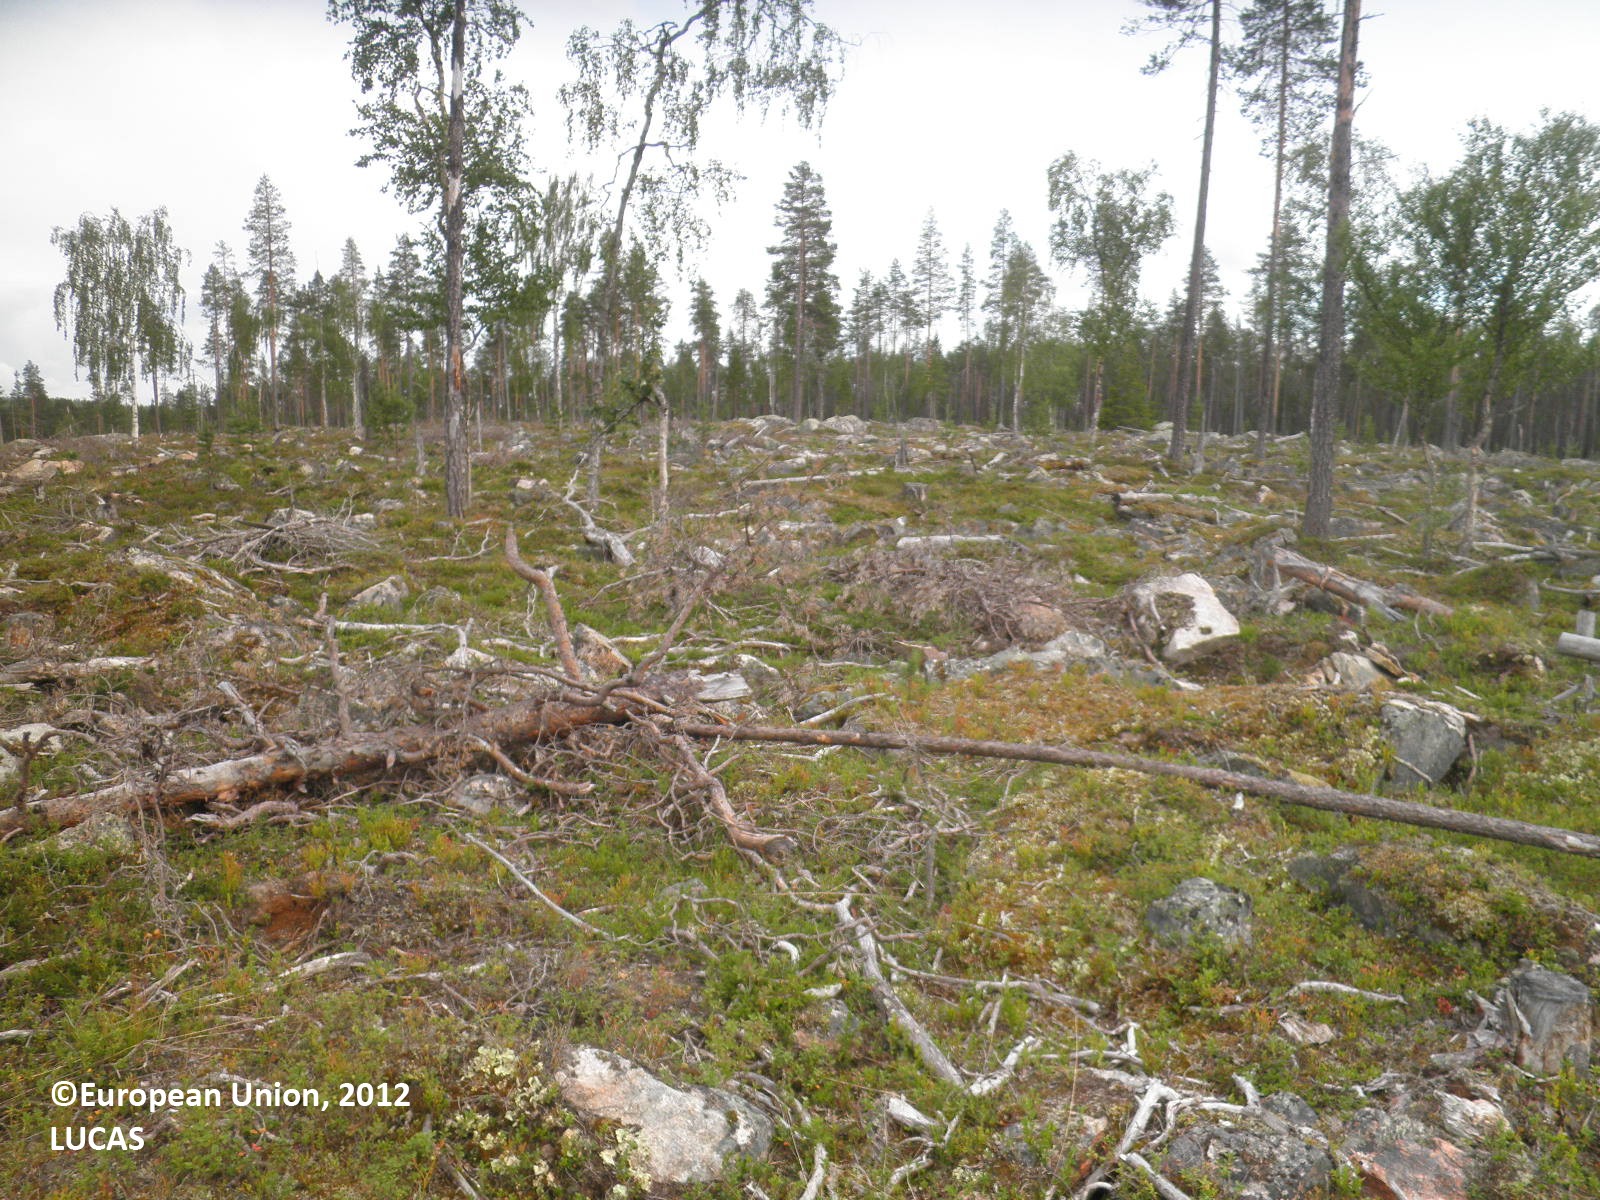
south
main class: Grassland
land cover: Grassland with sparse tree/shrub cover
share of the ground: > 75 %
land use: Forestry
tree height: < 5 m
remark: Clear cut
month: August
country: FI
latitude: 67.2735
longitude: 29.2486
